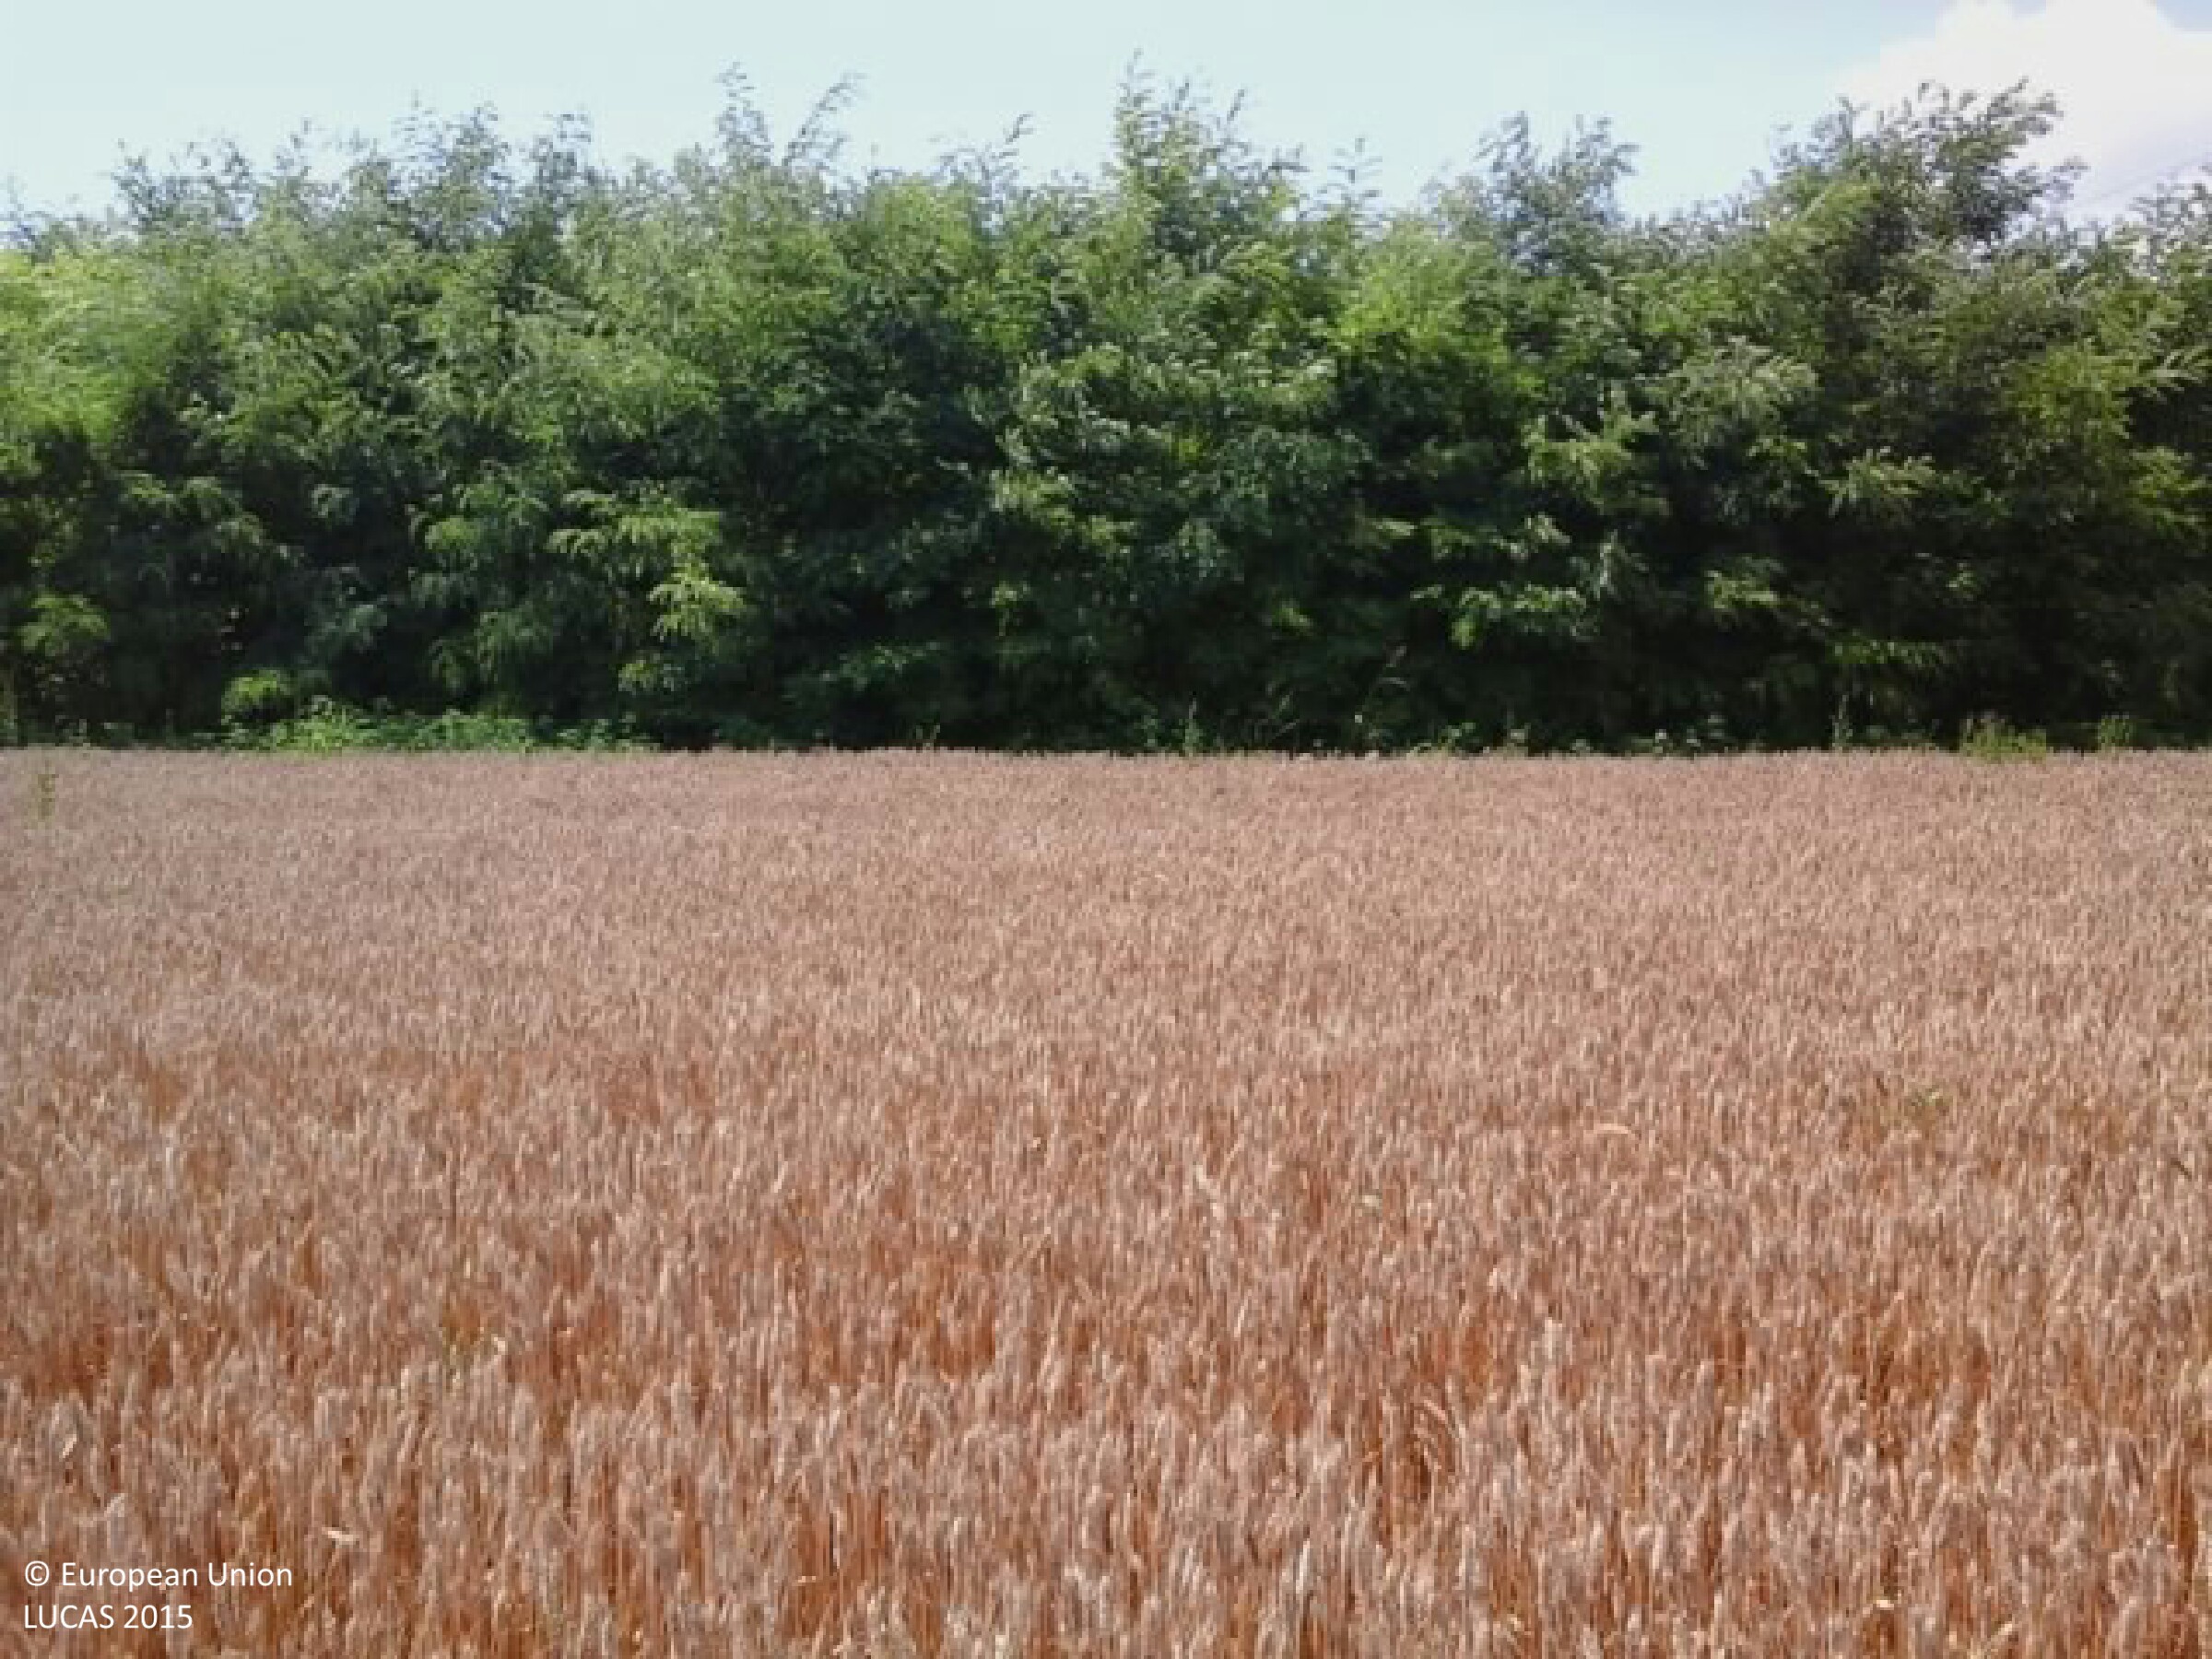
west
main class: Cropland
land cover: Common wheat
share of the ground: > 75 %
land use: Agriculture (excluding fallow land and kitchen gardens)
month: July
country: HU
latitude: 45.9457
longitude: 18.8727
